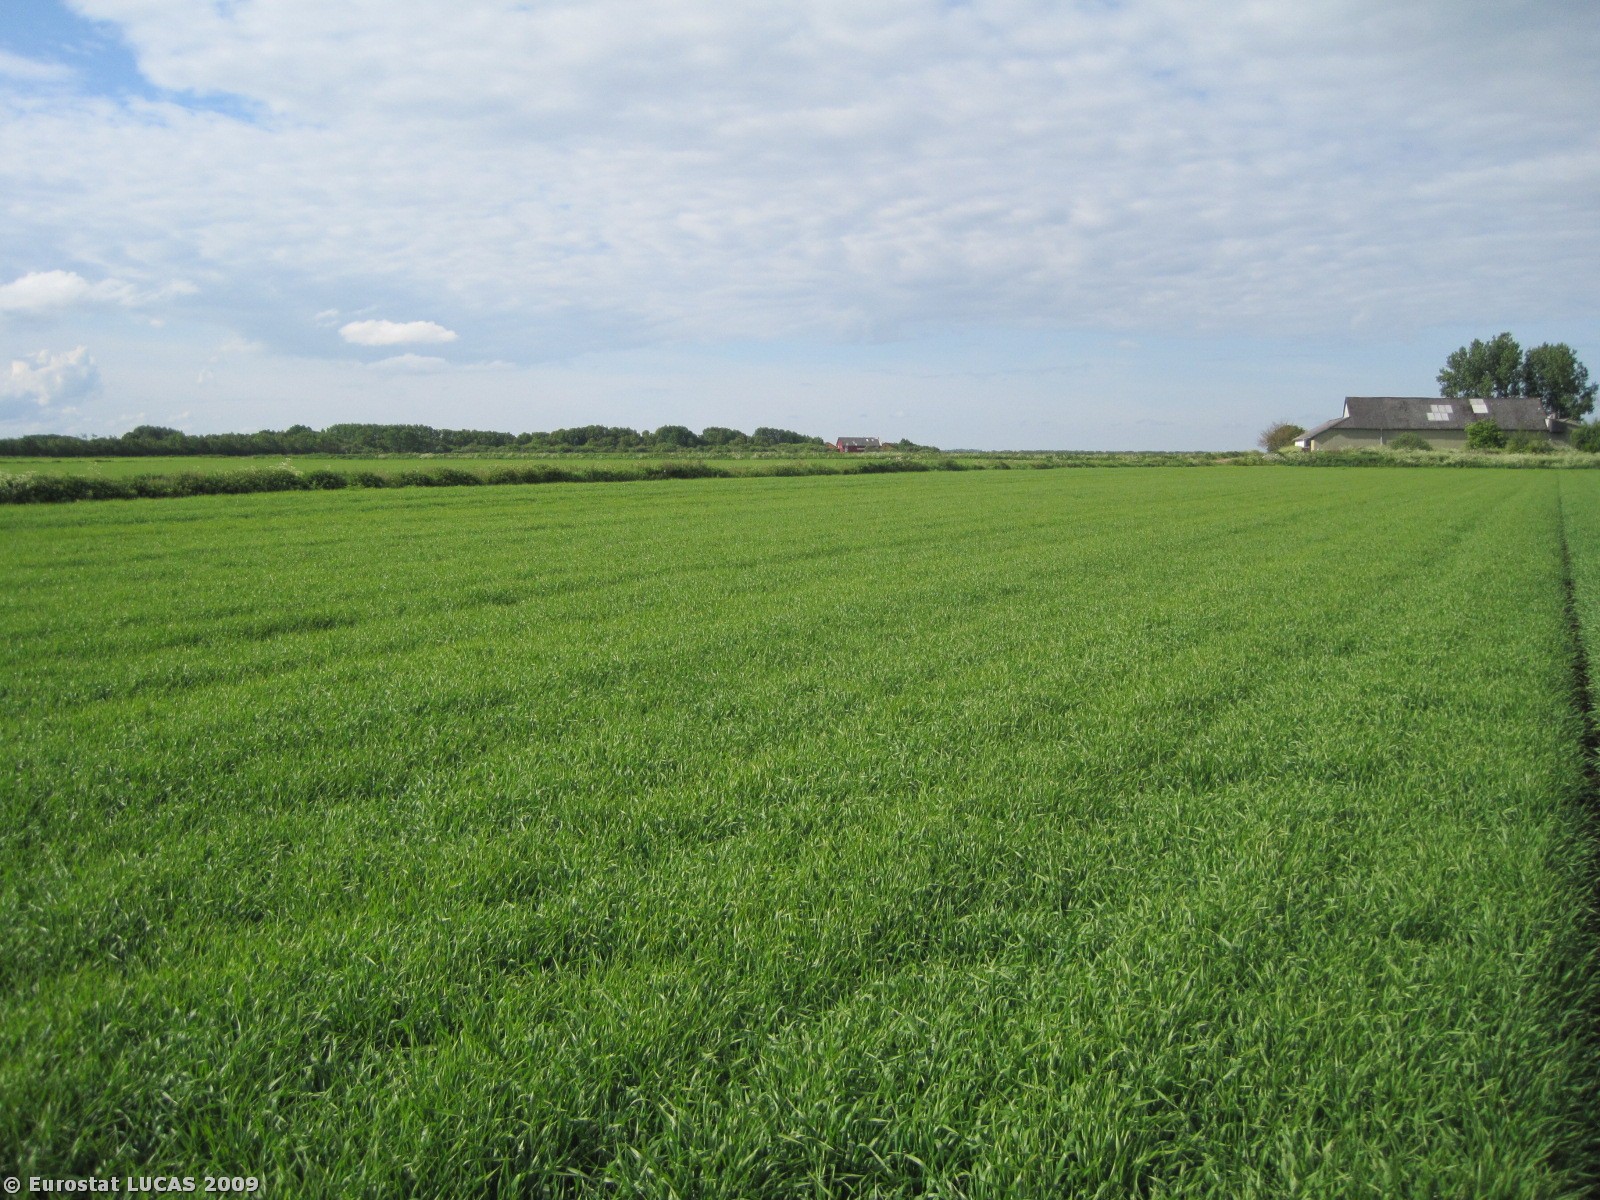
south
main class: Cropland
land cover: Barley
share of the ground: > 75 %
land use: Agriculture (excluding fallow land and kitchen gardens)
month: June
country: DK
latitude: 57.2123
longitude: 9.8182
